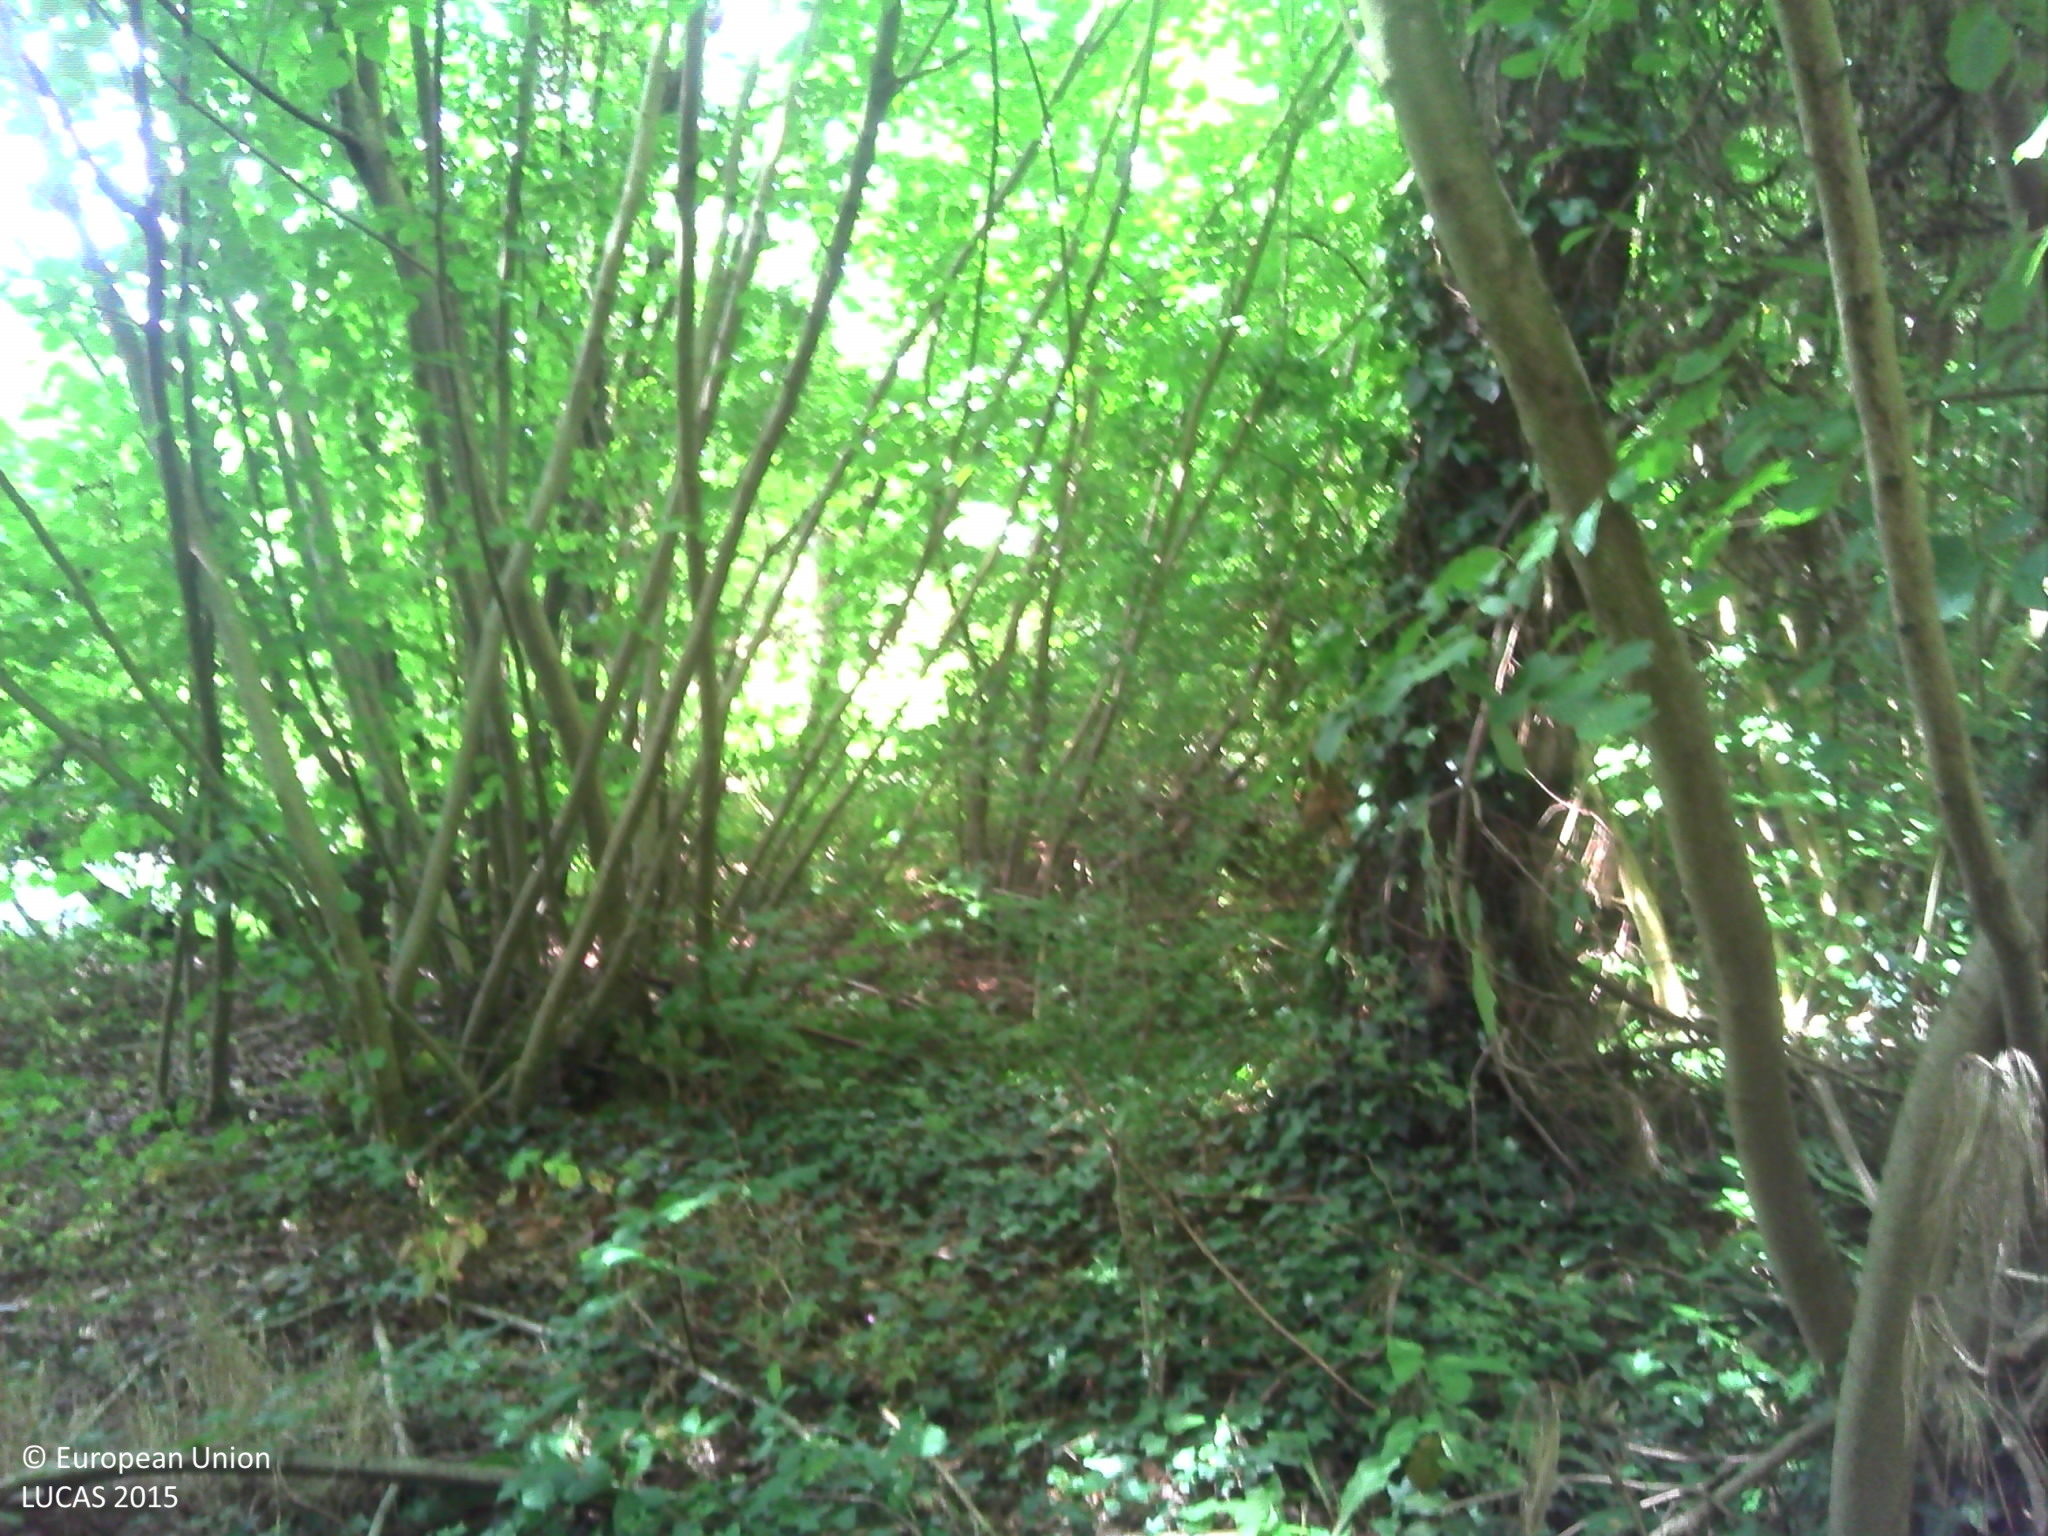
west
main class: Woodland
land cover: Broadleaved woodland
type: mesophytic deciduous forest
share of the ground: > 75 %
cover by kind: broadleaved forest trees 95 %, coniferous forest trees 5 %
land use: Forestry
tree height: > 5 m
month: August
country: FR
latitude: 46.7794
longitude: -1.3669
